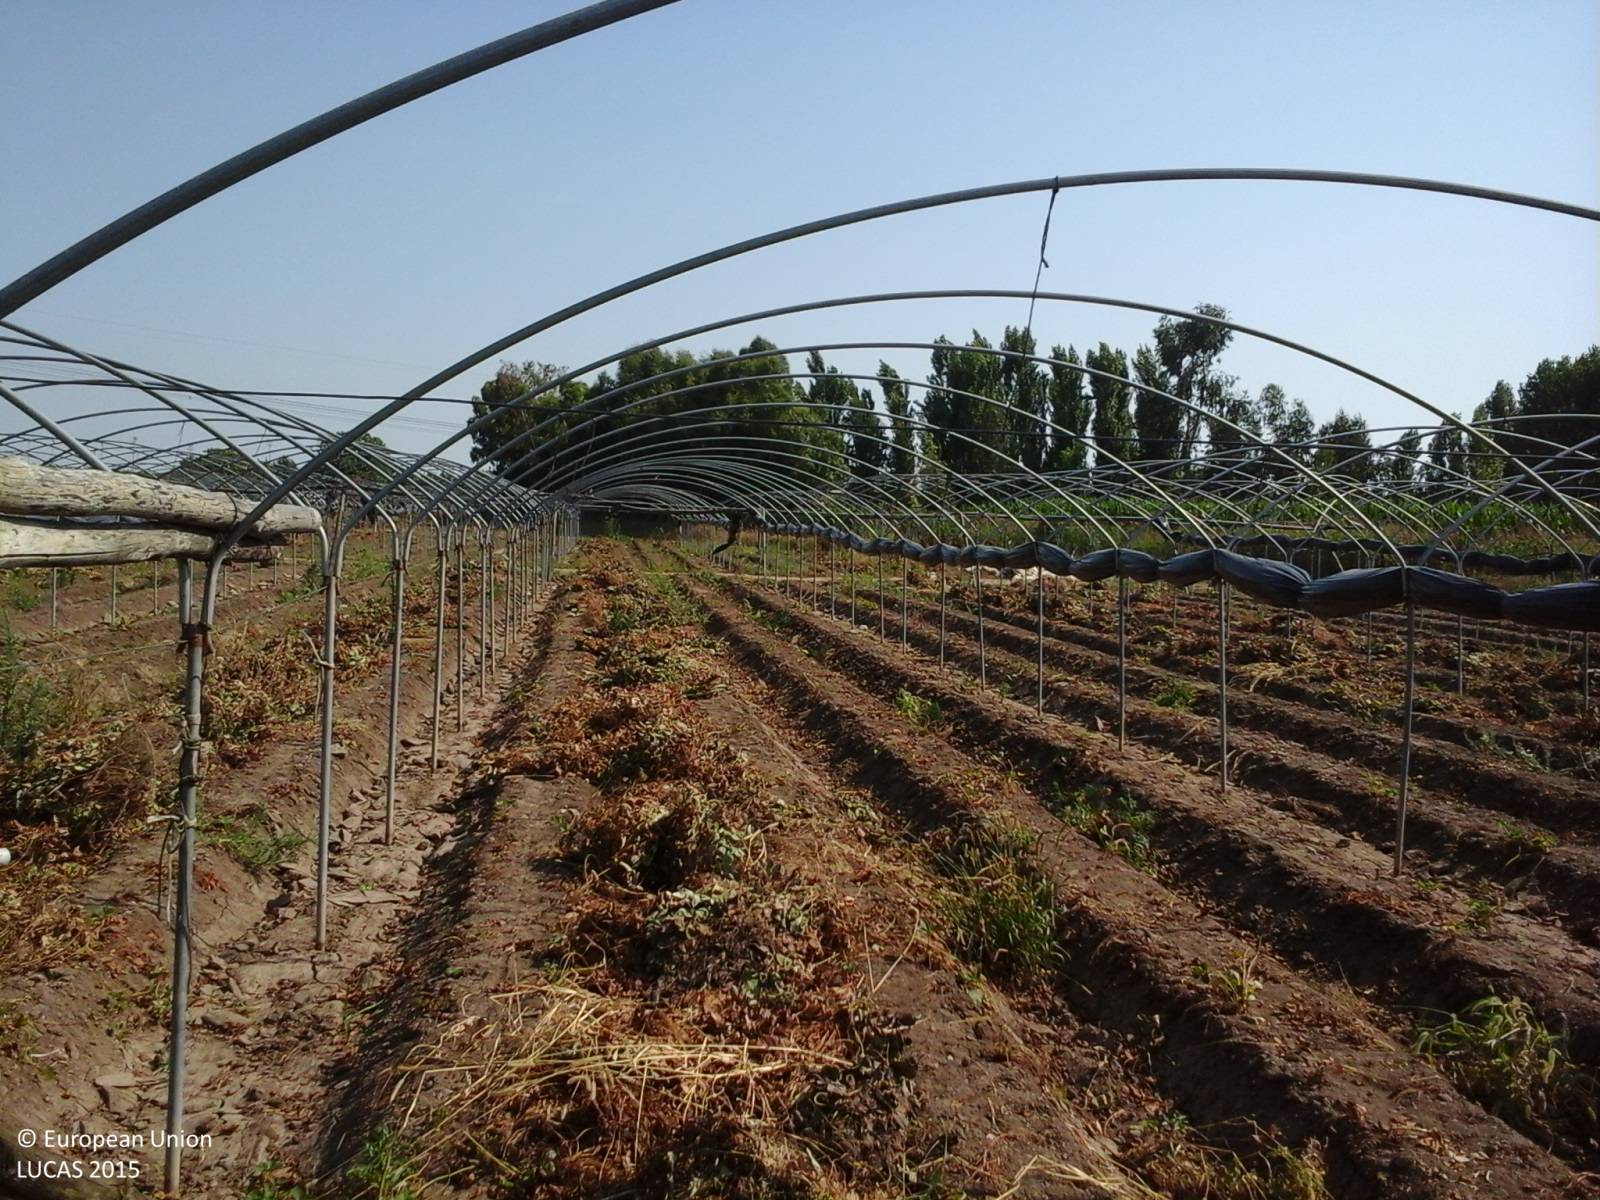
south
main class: Cropland
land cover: Maize
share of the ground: > 75 %
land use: Agriculture (excluding fallow land and kitchen gardens)
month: July
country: IT
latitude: 41.0316
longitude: 14.1343
